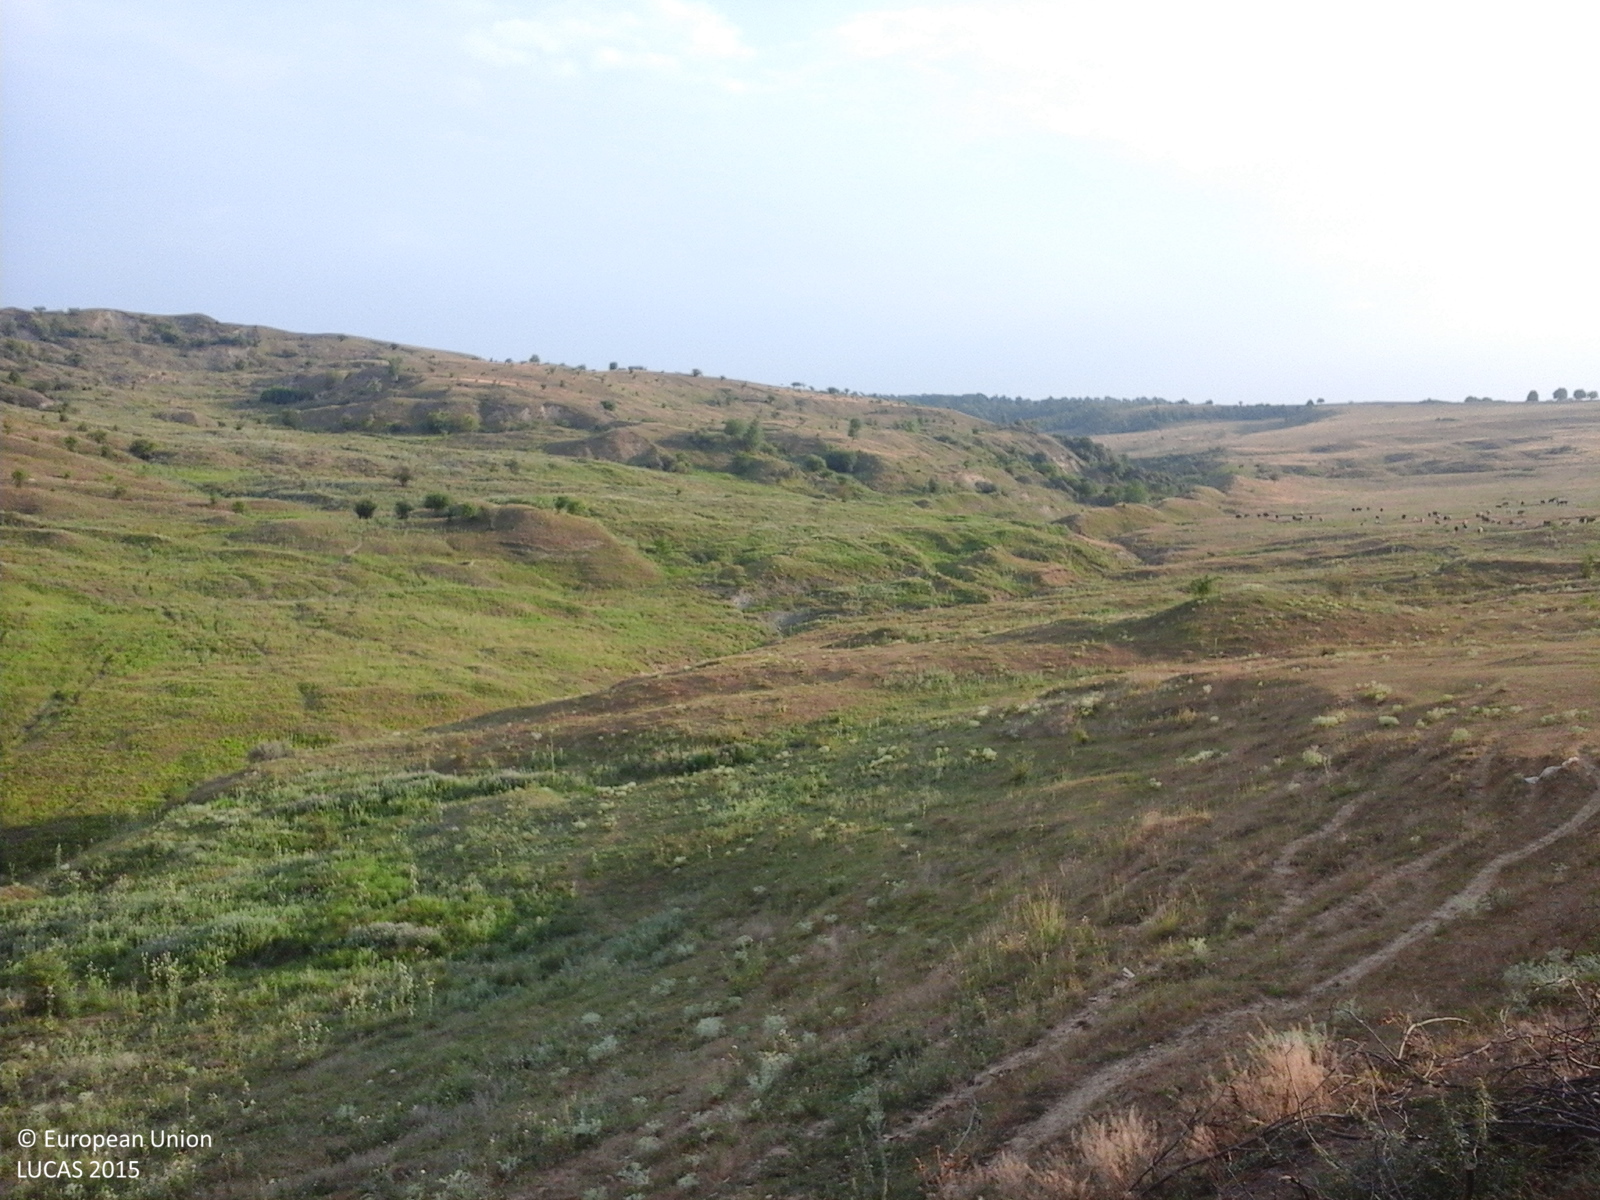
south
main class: Grassland
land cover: Grassland with sparse tree/shrub cover
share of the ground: > 75 %
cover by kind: herbaceous plants 90 %, broadleaved forest trees 5 %, shrubs 5 %
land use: Agriculture (excluding fallow land and kitchen gardens)
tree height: > 5 m
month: July
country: RO
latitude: 46.1885
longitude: 26.7885
